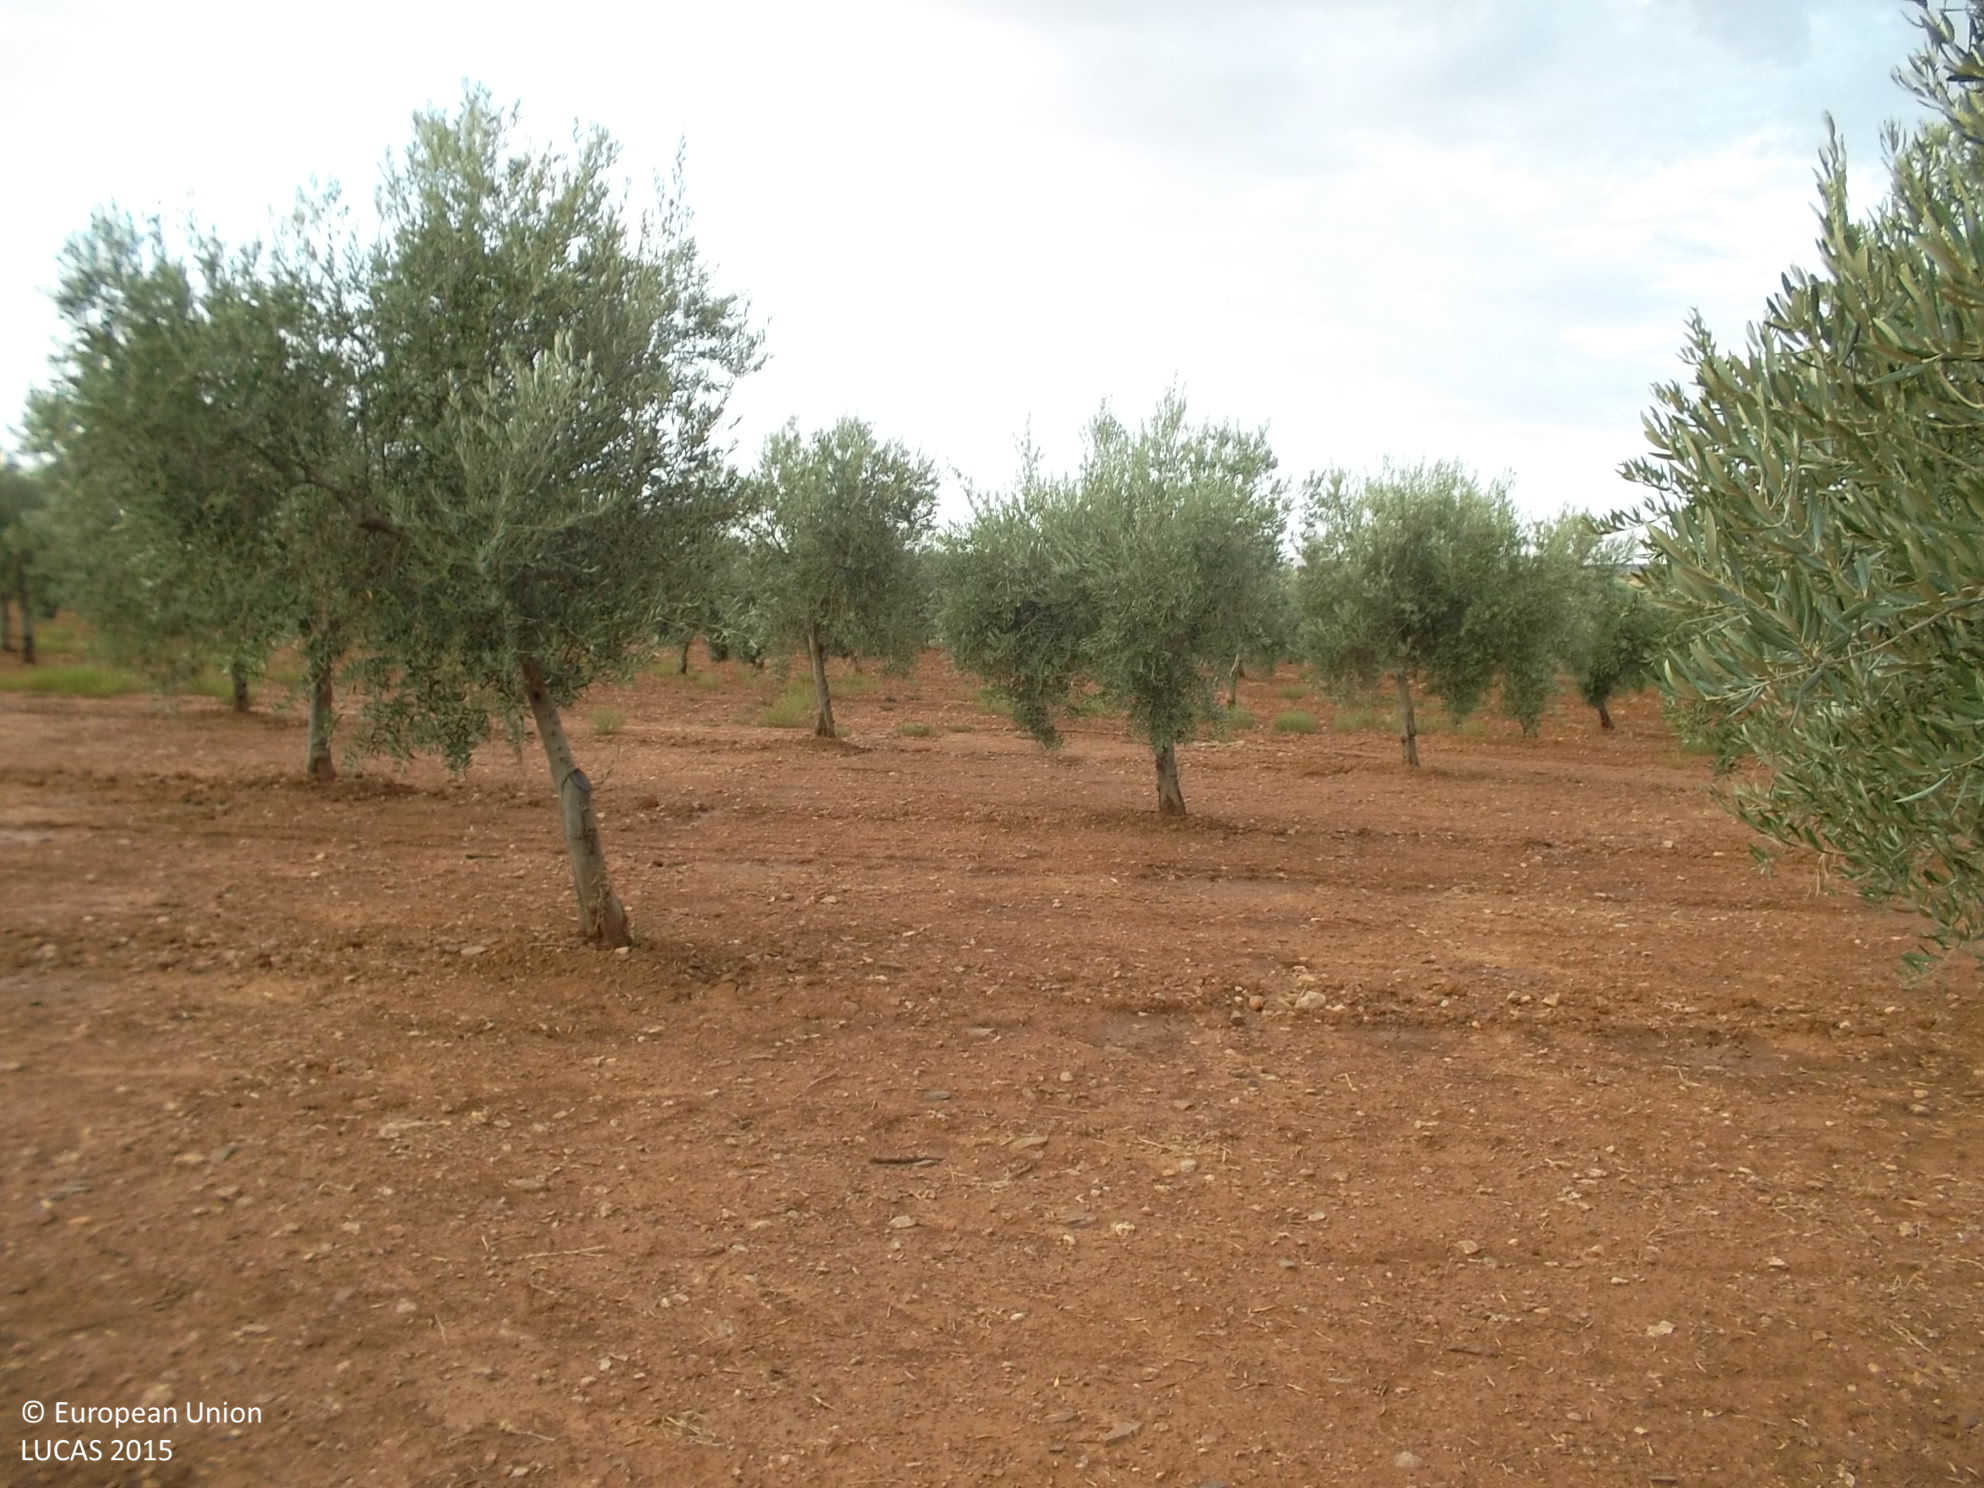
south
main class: Cropland
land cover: Olive groves
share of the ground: 50 - 75 %
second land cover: Other bare soil
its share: > 75 %
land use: Agriculture (excluding fallow land and kitchen gardens)
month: July
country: ES
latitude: 38.5861
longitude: -5.3838
